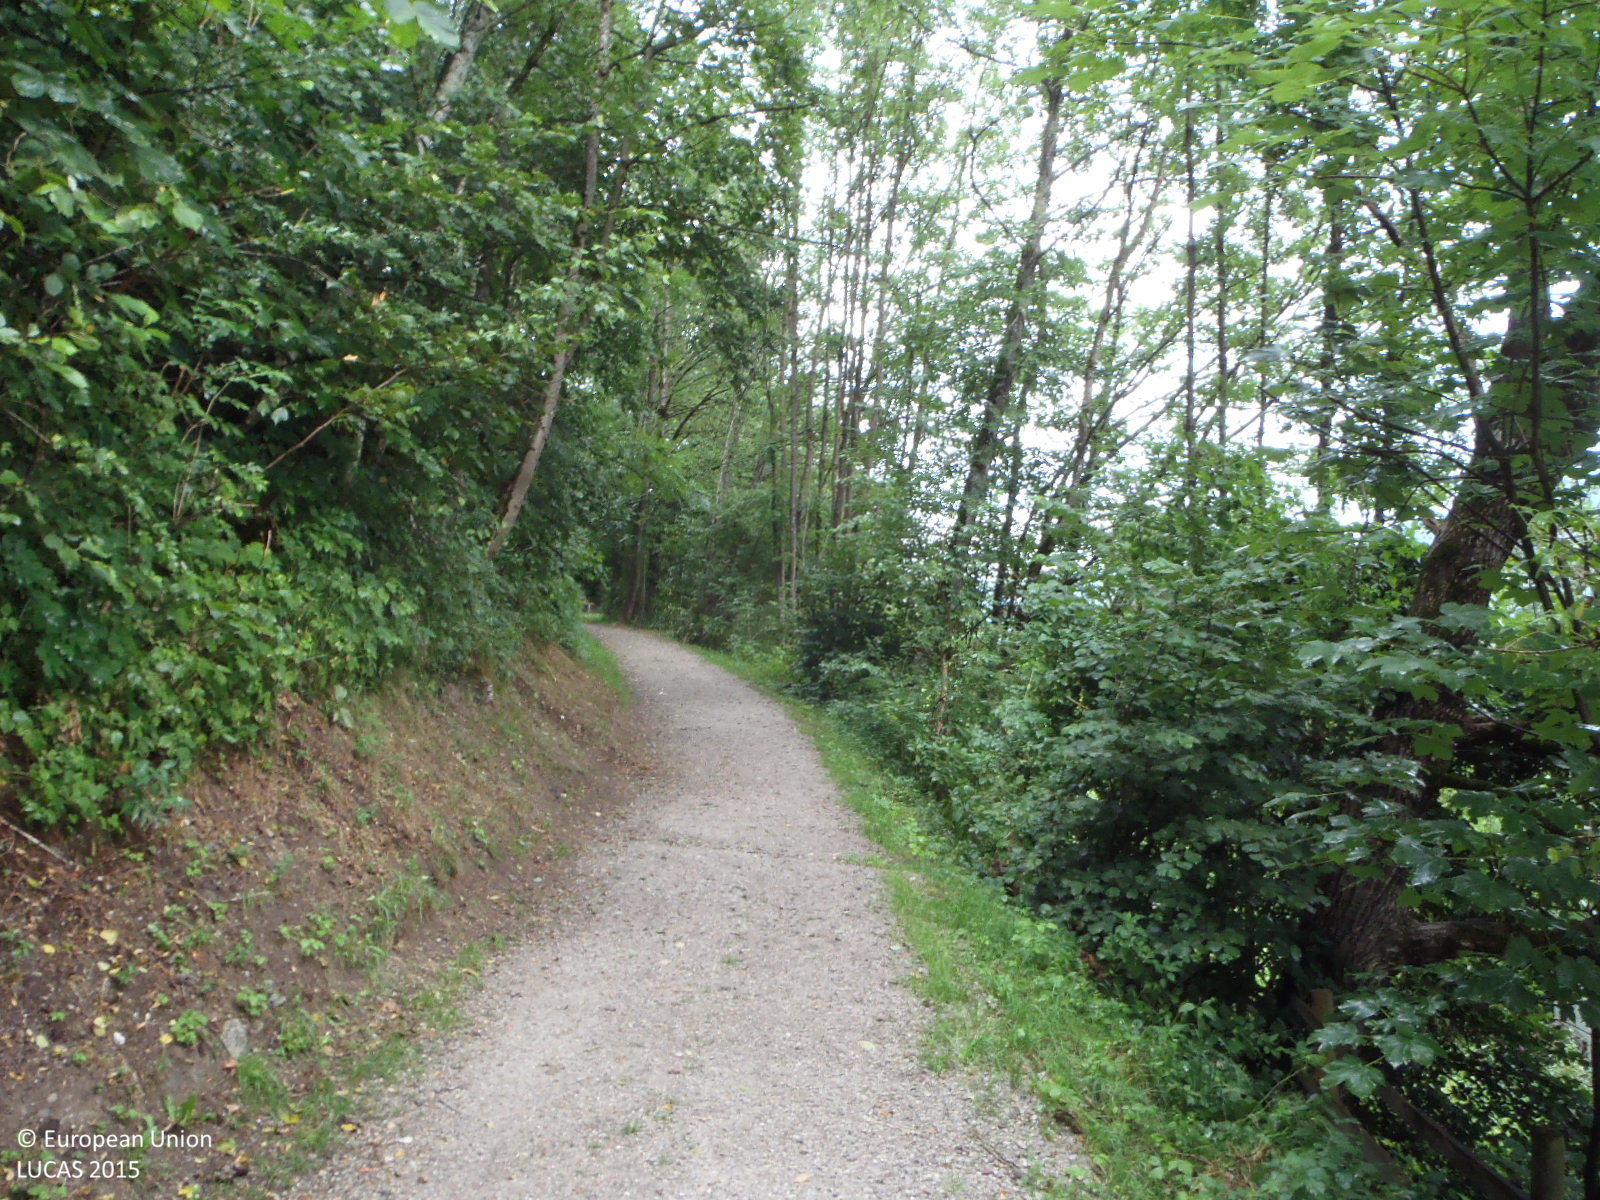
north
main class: Woodland
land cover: Spruce dominated mixed woodland
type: alpine coniferous forest
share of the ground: > 75 %
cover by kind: broadleaved forest trees 70 %, coniferous forest trees 30 %
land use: Forestry
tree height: > 5 m
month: July
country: AT
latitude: 47.1816
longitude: 11.8590
